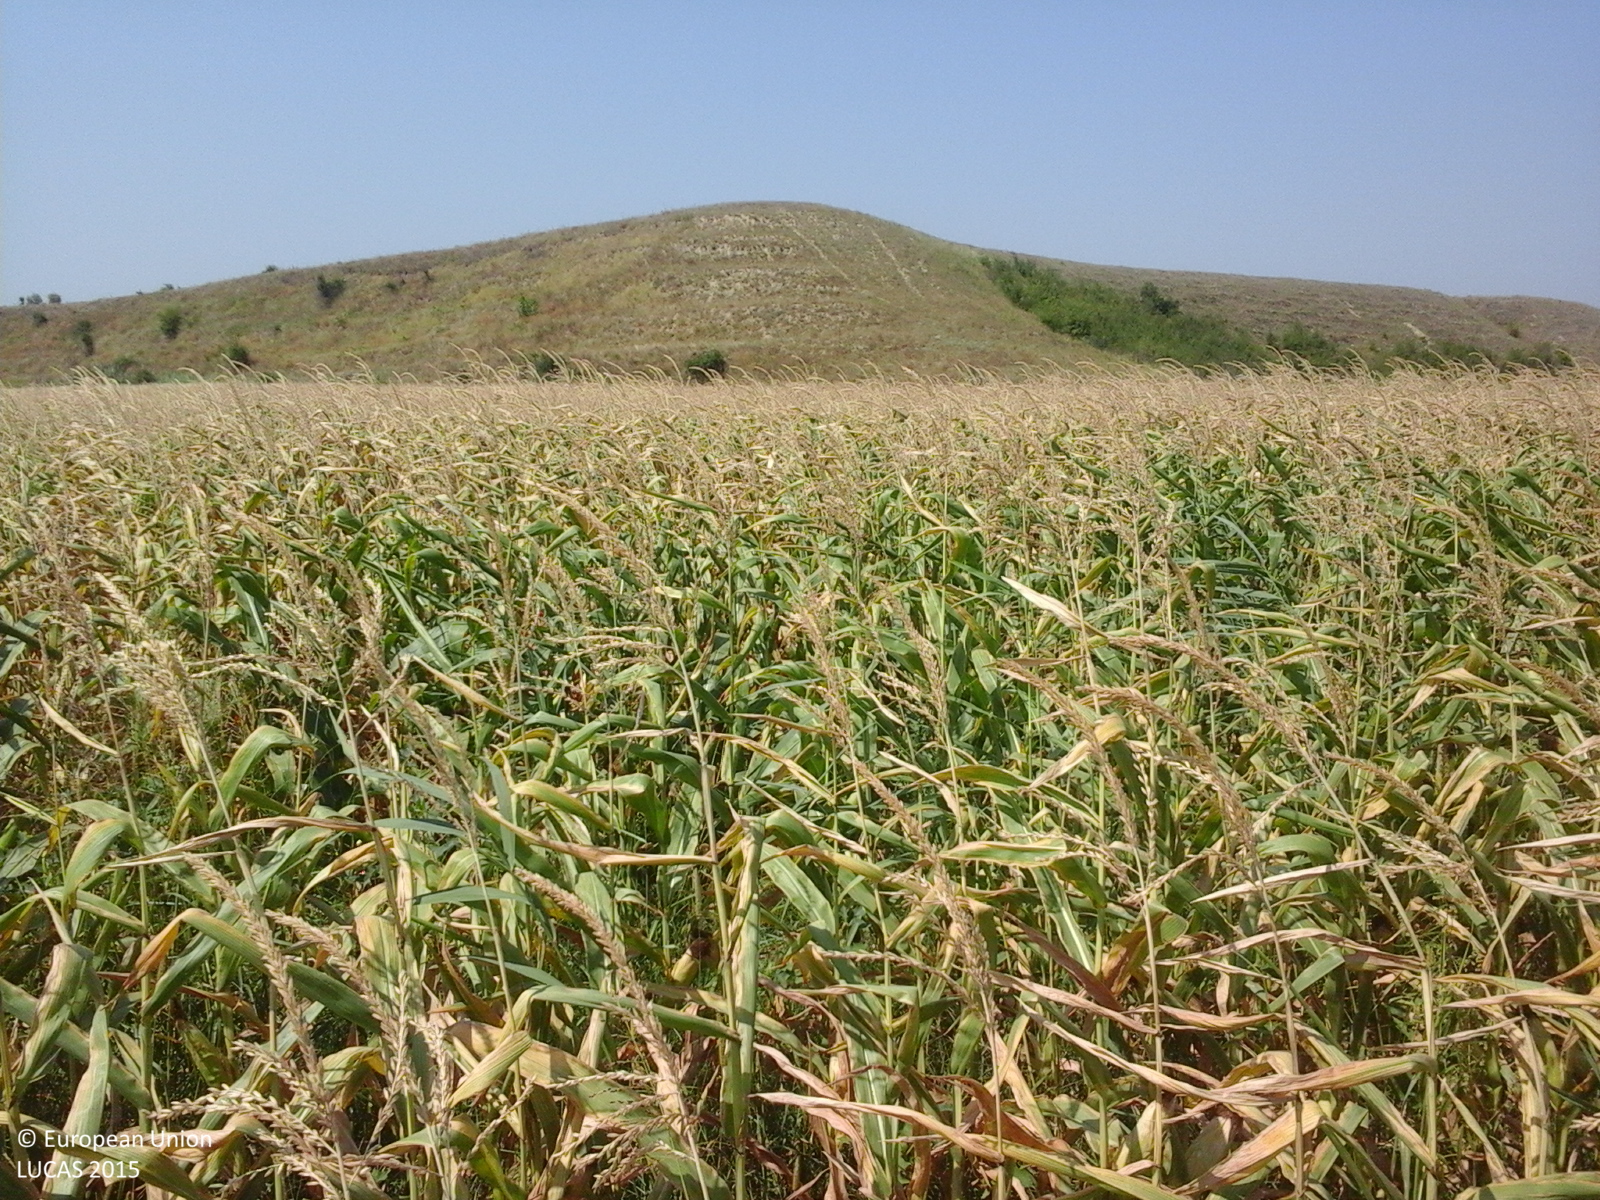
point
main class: Cropland
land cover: Maize
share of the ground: > 75 %
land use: Agriculture (excluding fallow land and kitchen gardens)
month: August
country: RO
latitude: 45.2406
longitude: 27.4100
